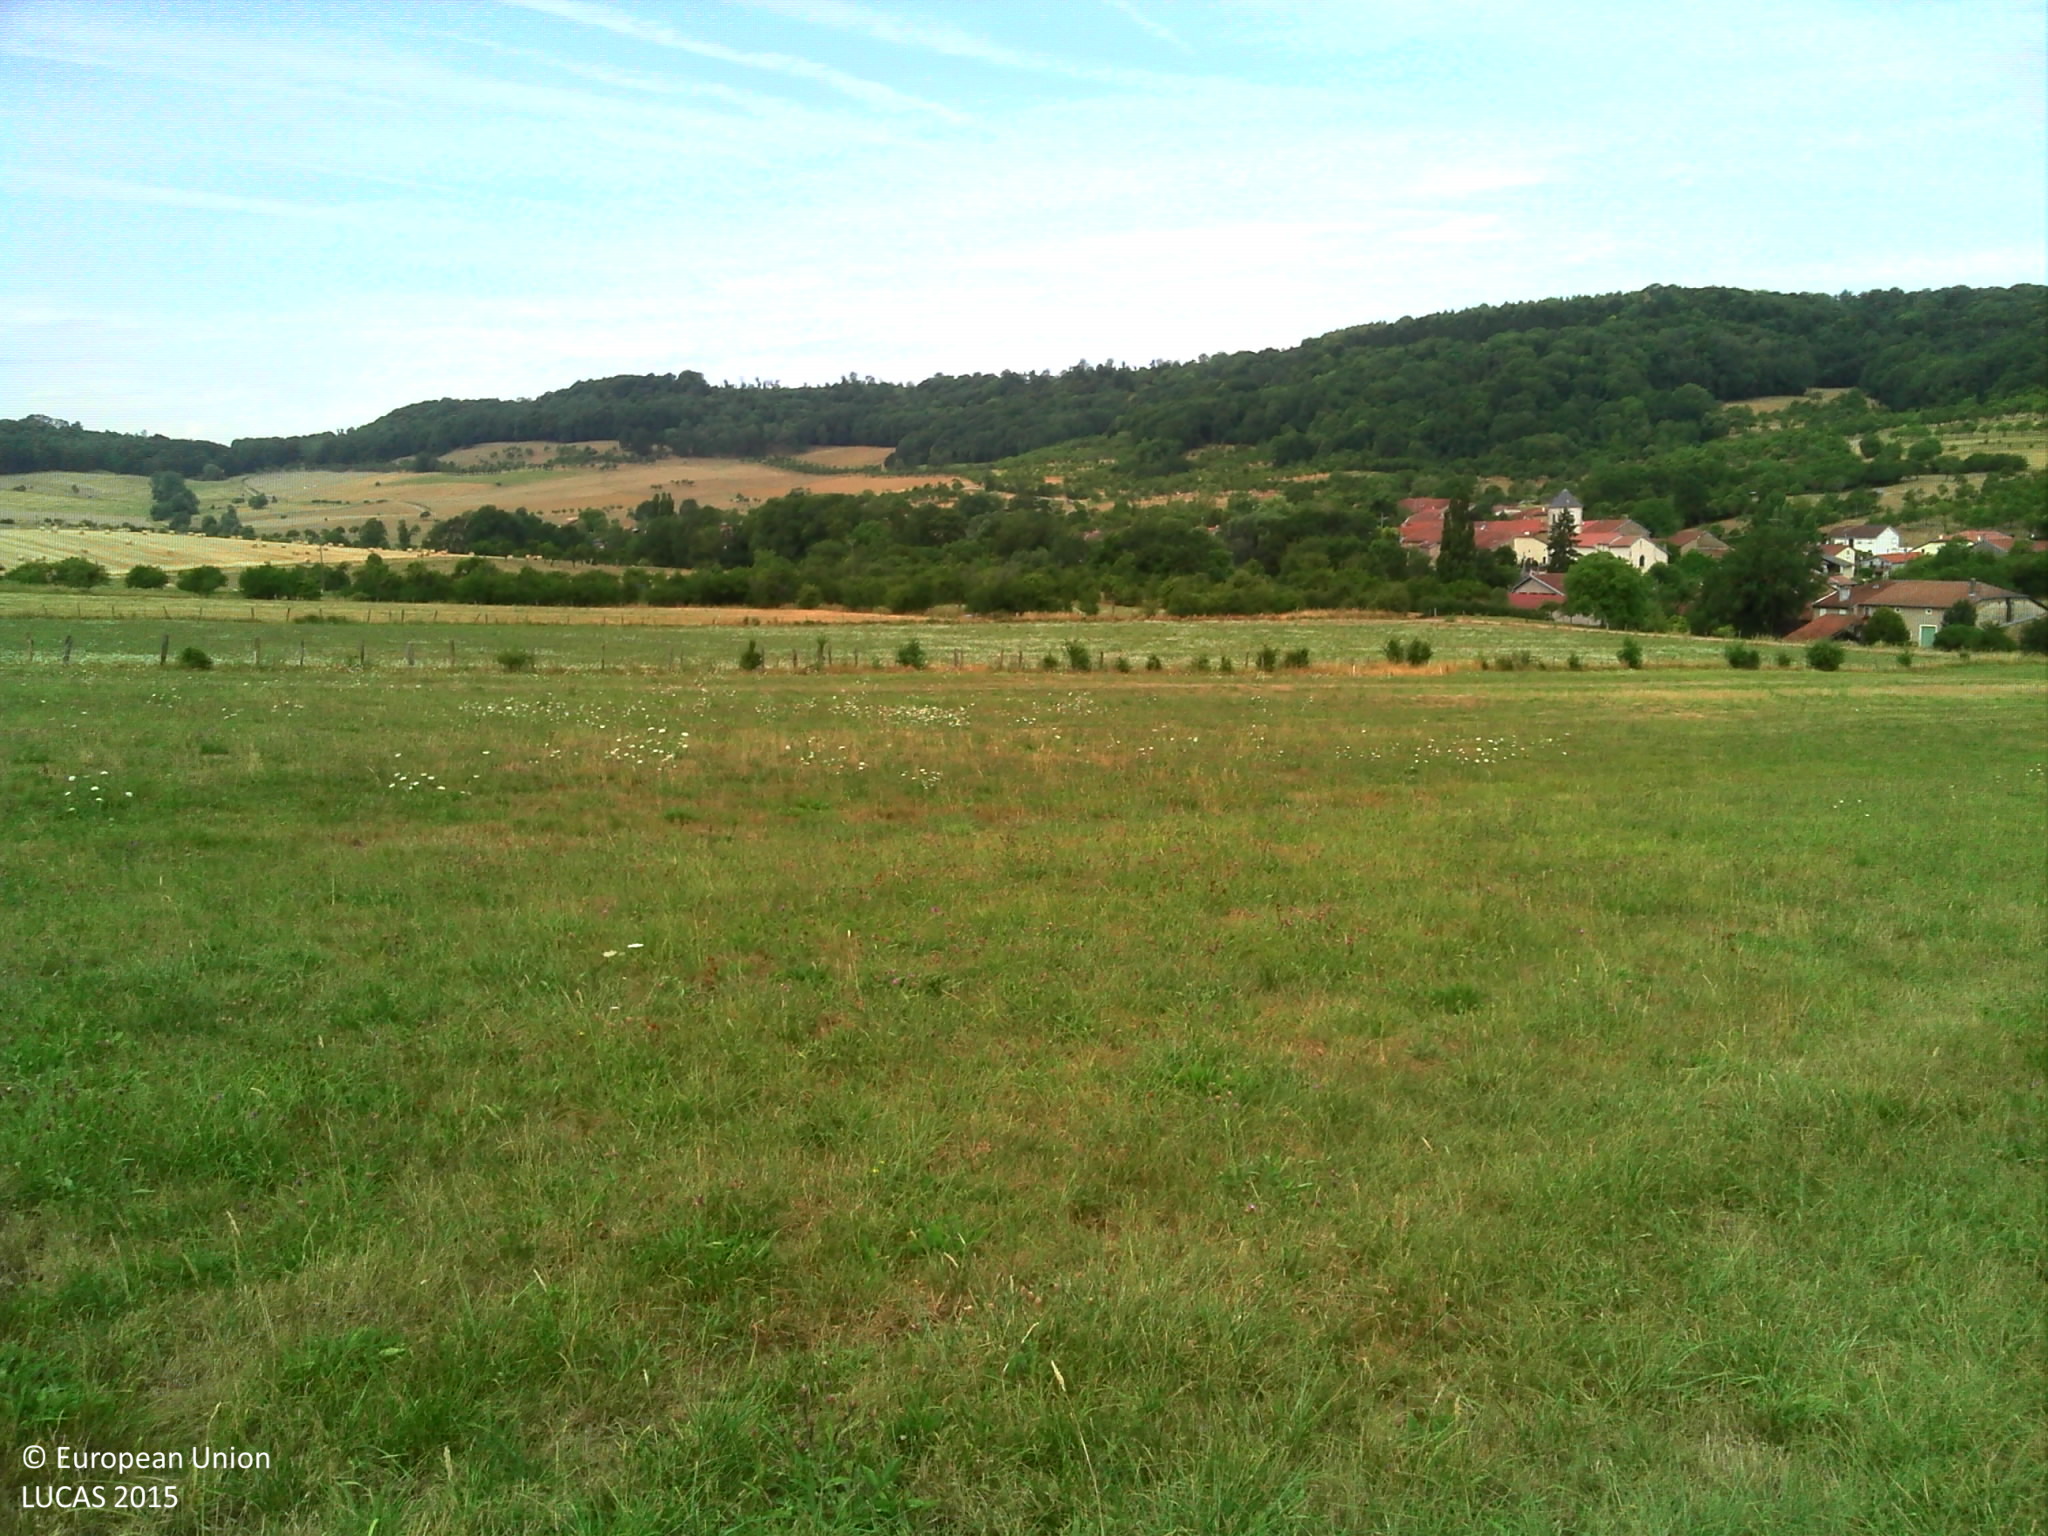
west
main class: Grassland
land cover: Grassland without tree/shrub cover
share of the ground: > 75 %
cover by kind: herbaceous plants 100 %
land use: Agriculture (excluding fallow land and kitchen gardens)
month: July
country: FR
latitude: 48.4038
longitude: 6.0152
